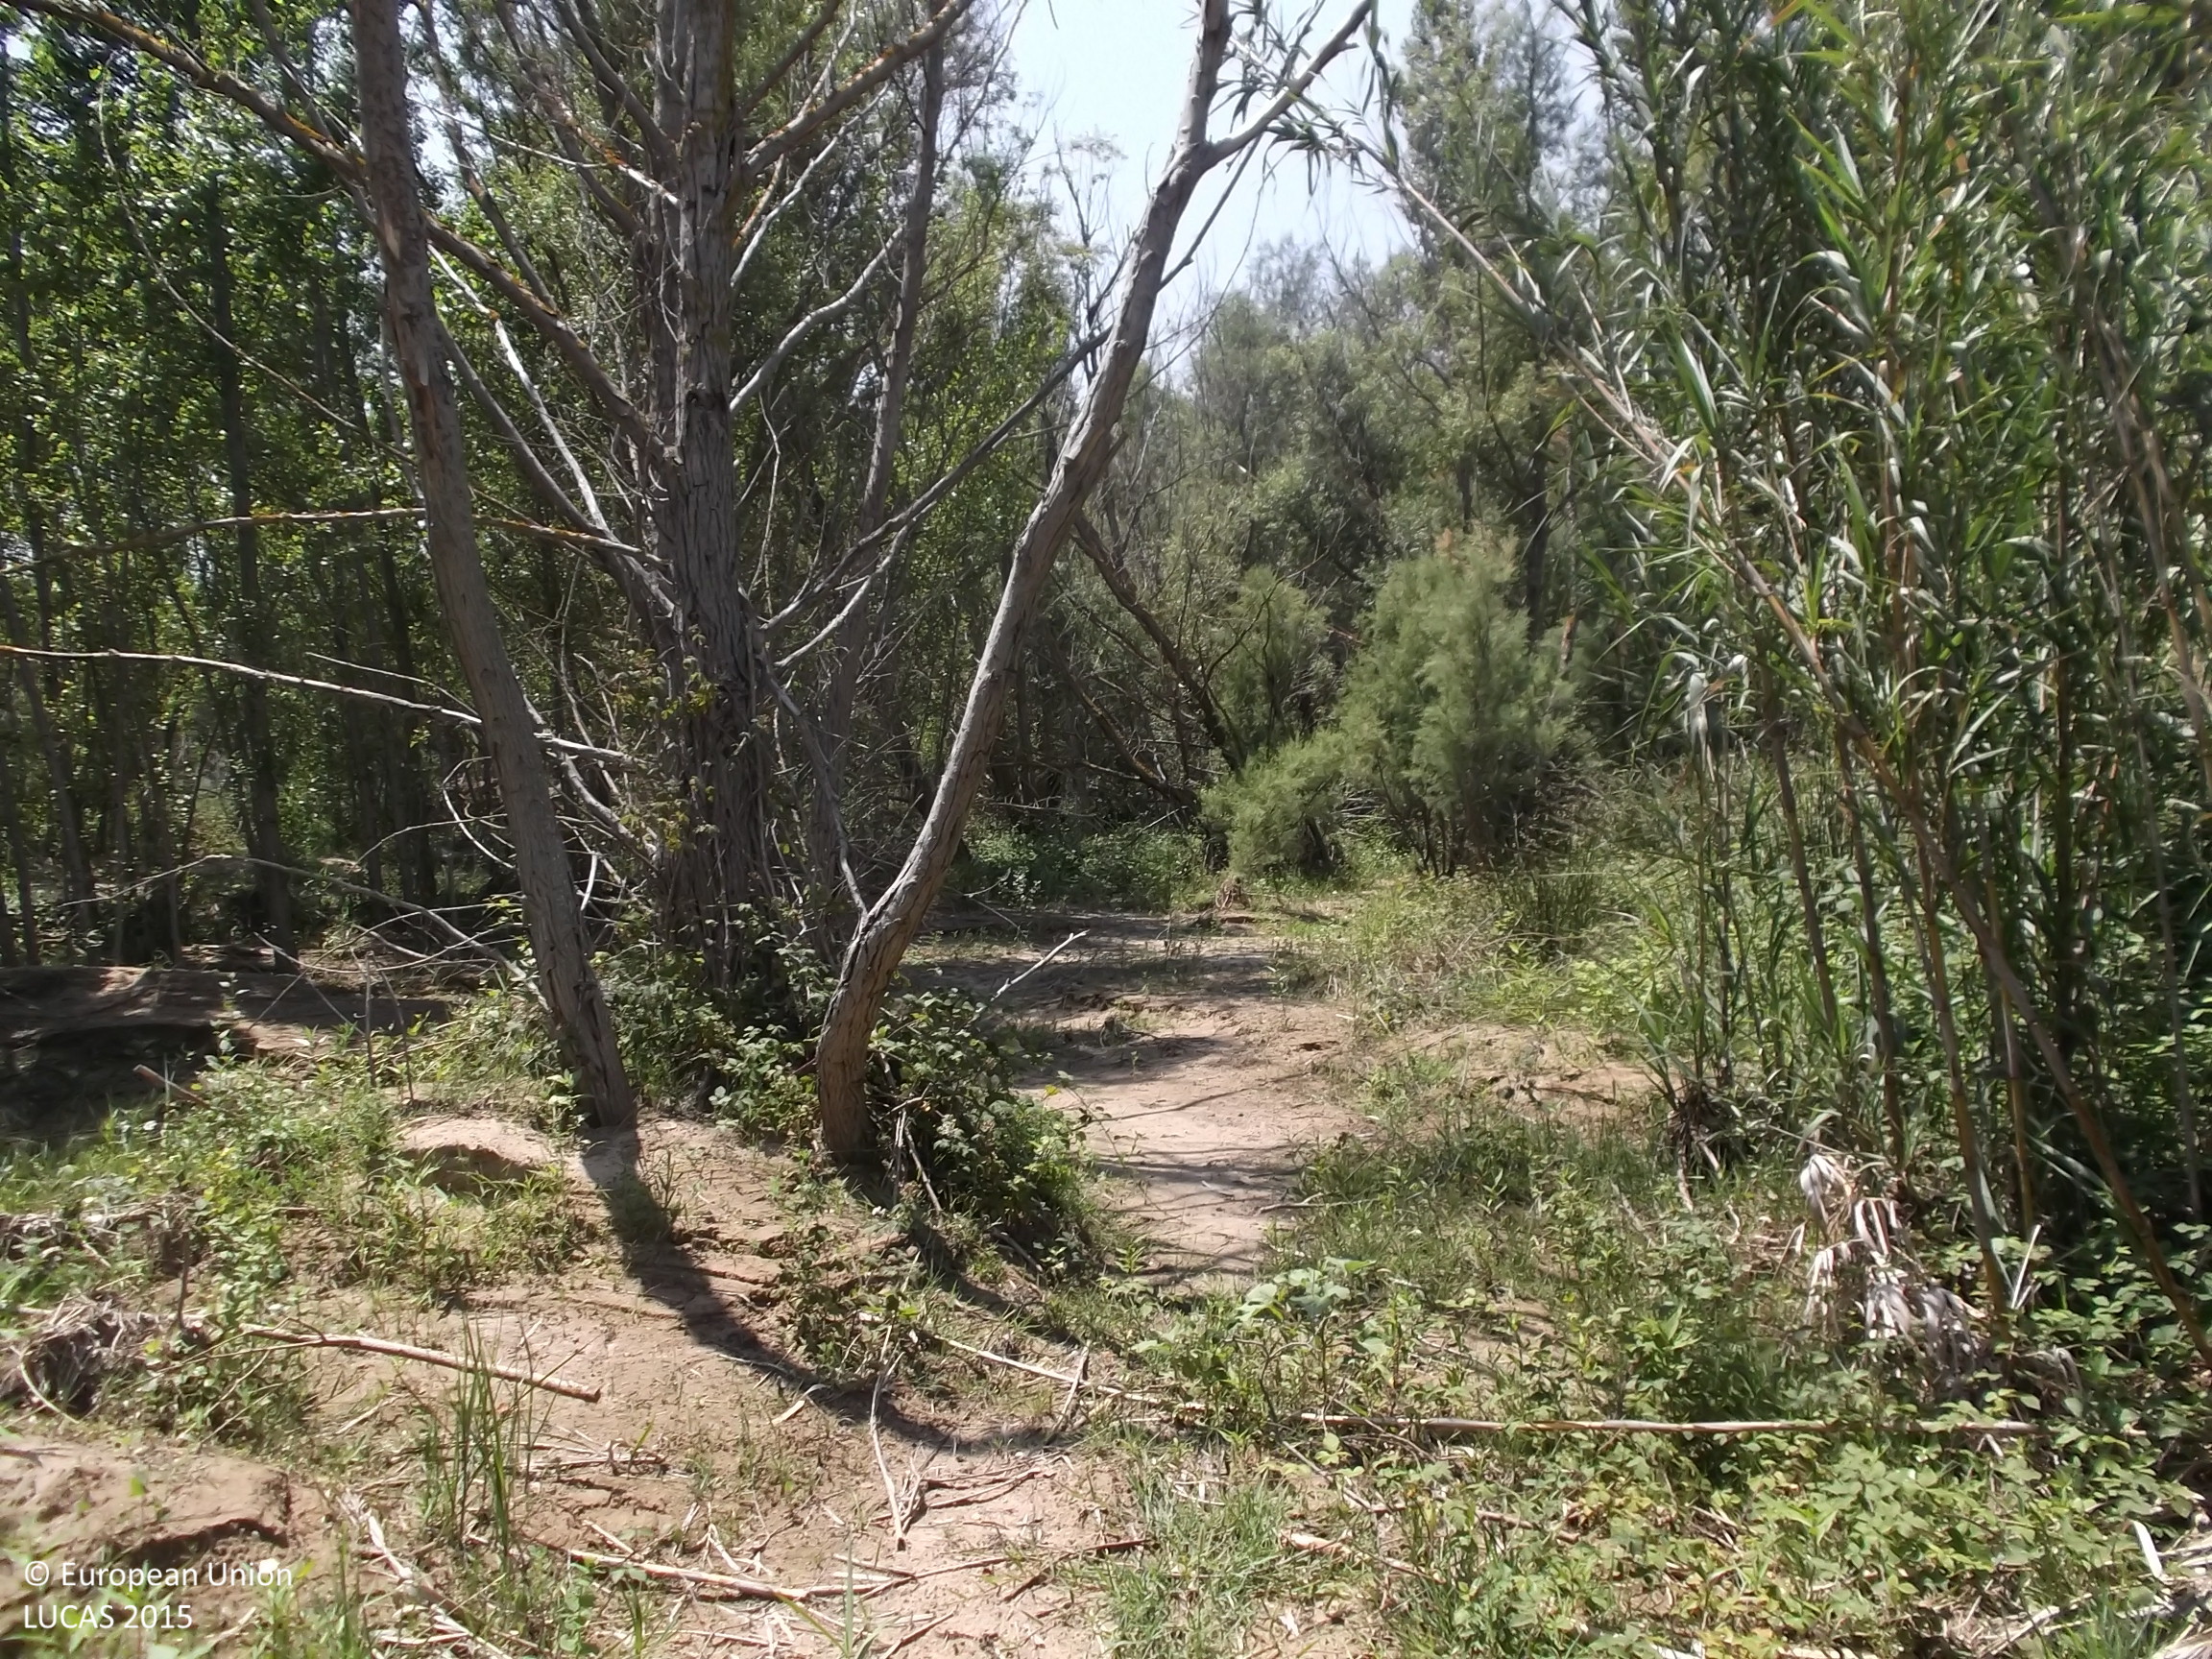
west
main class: Woodland
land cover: Broadleaved woodland
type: floodplain forest
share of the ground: 50 - 75 %
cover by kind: broadleaved forest trees 70 %, shrubs 15 %, herbaceous plants 10 %, unconsolidated bare surface 5 %
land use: Semi-natural and natural areas not in use
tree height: > 5 m
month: June
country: ES
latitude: 42.2243
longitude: -2.0443
